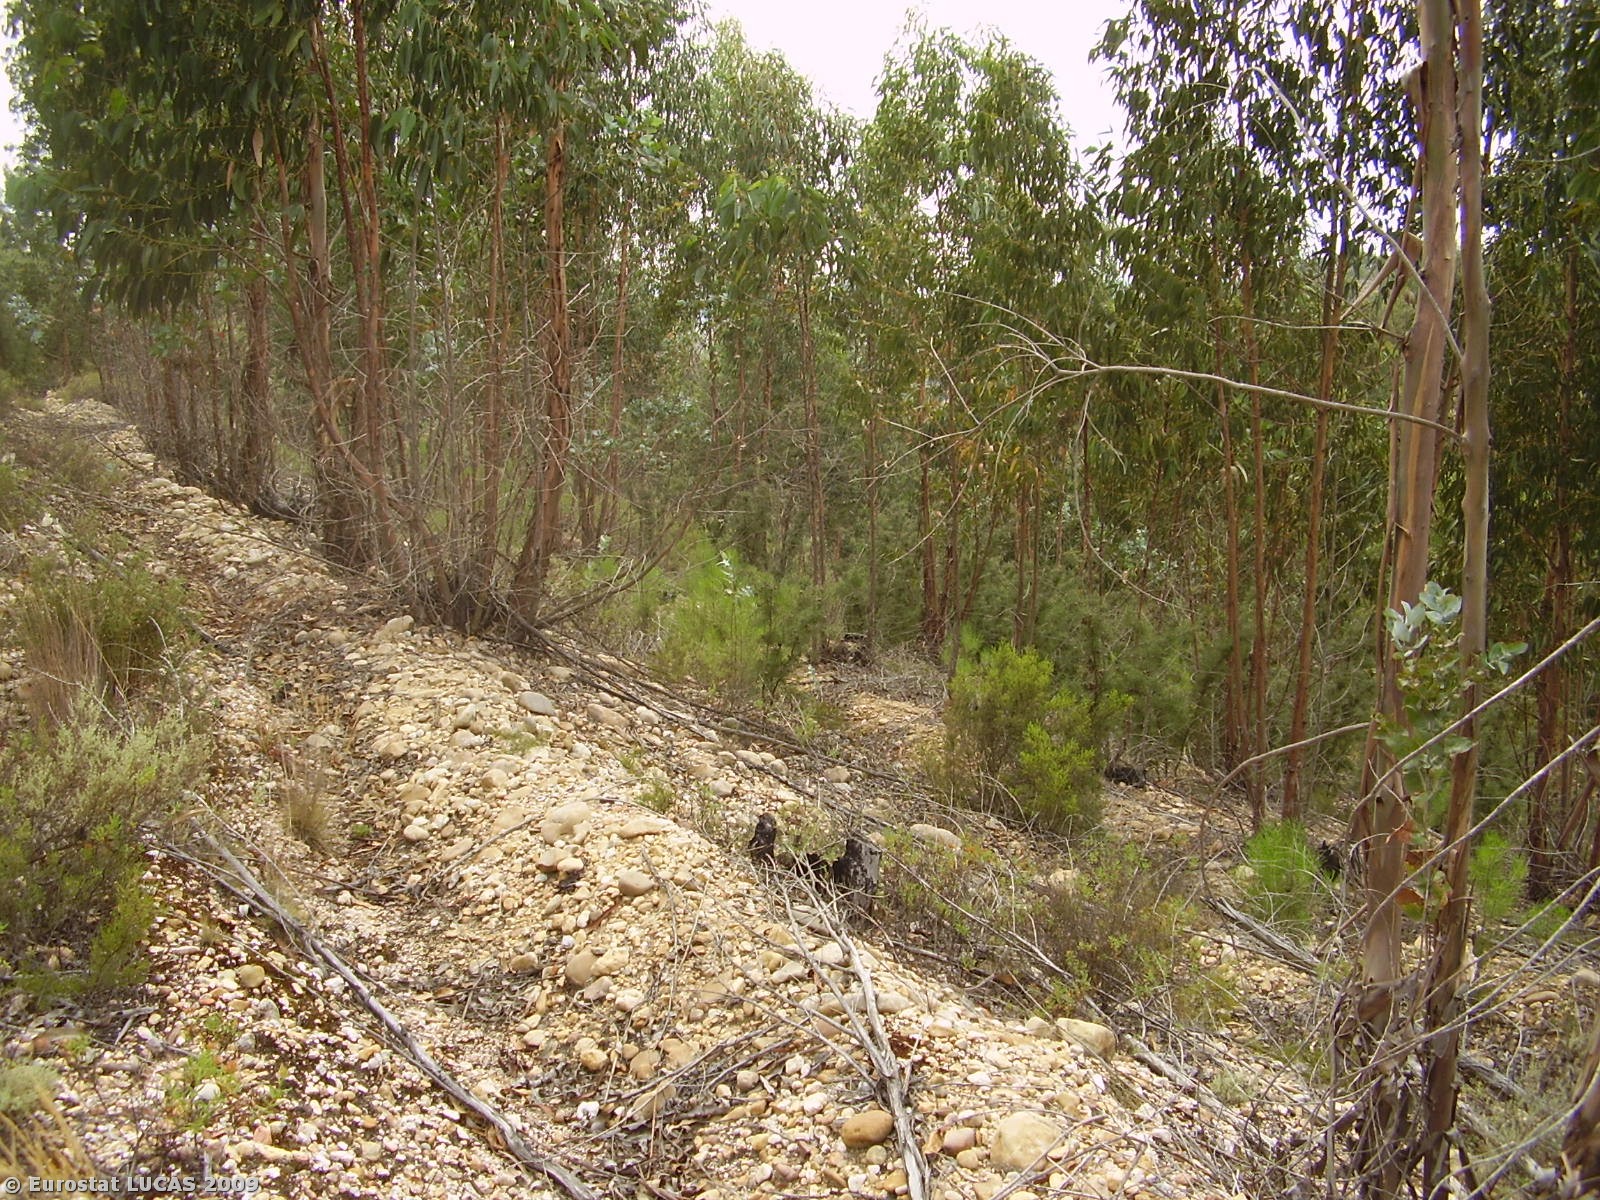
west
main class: Woodland
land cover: Broadleaved woodland
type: plantations and self-sown exotic forest
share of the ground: 25 - 50 %
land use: Forestry
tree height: > 5 m
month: July
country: PT
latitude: 39.4847
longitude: -8.2372
